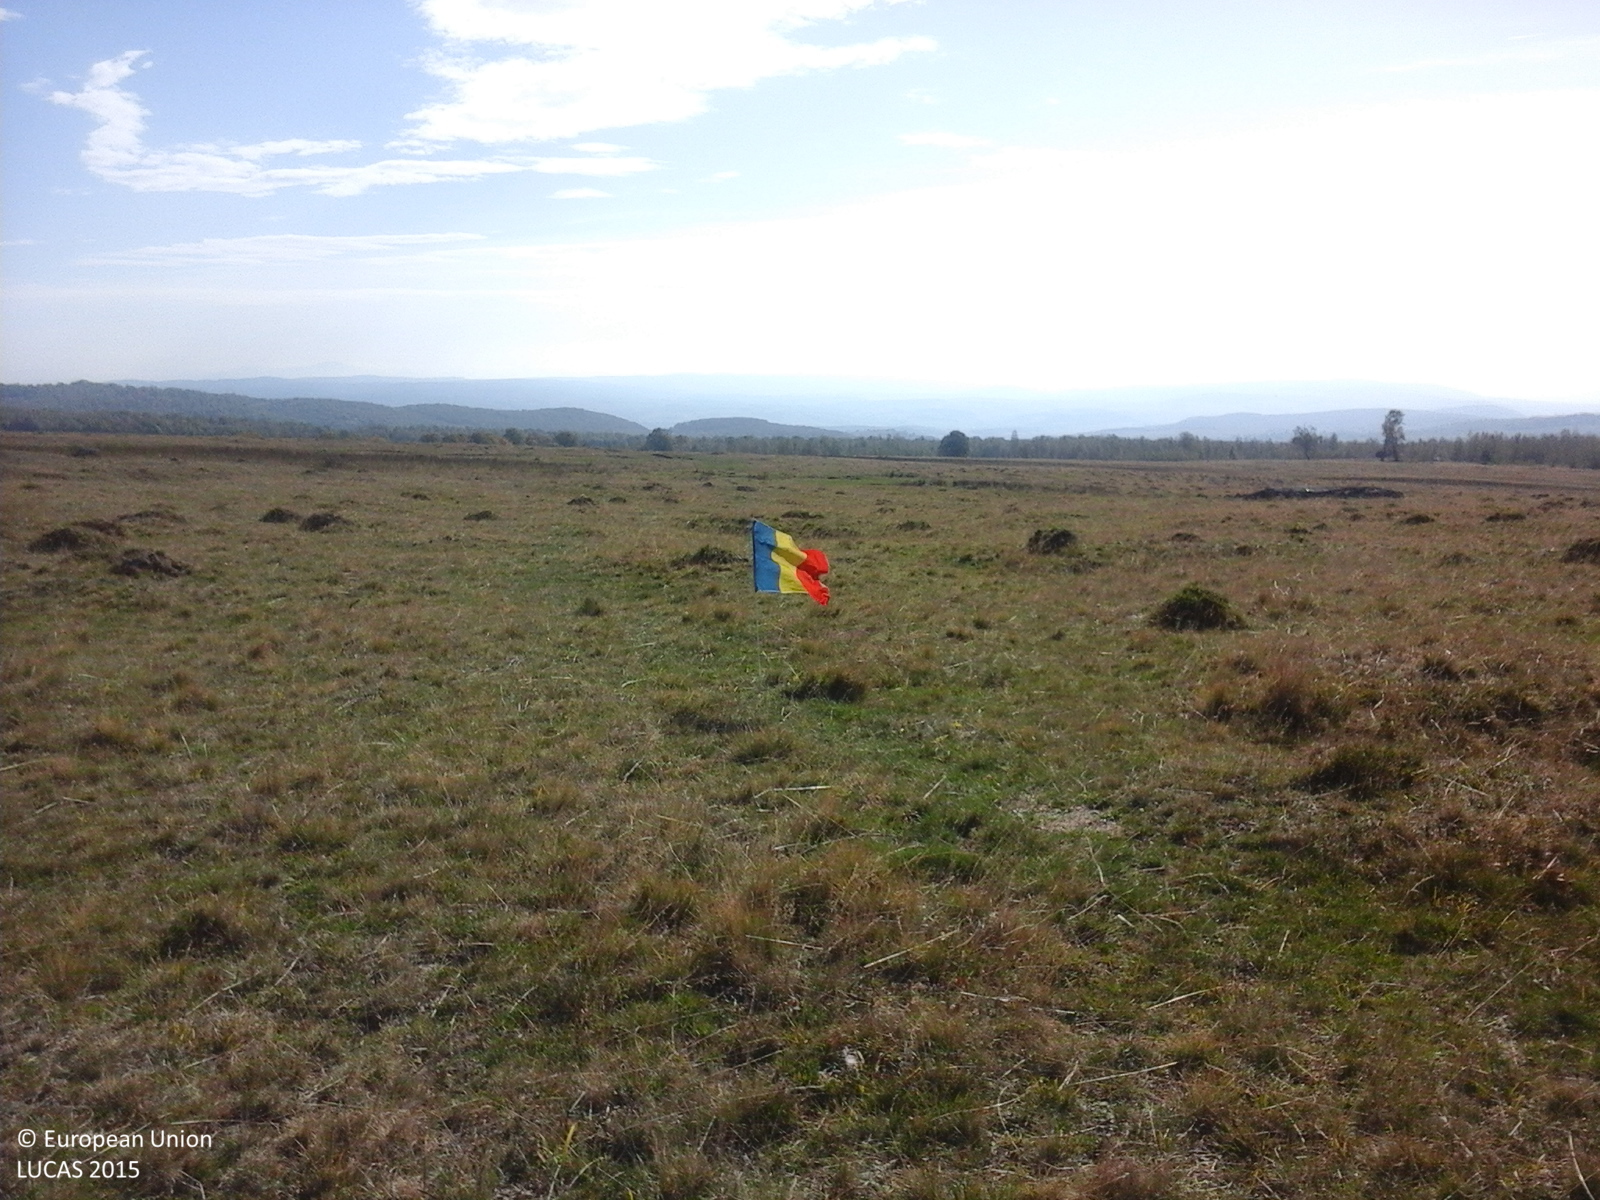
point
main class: Grassland
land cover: Grassland without tree/shrub cover
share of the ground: > 75 %
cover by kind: herbaceous plants 100 %
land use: Agriculture (excluding fallow land and kitchen gardens)
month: October
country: RO
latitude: 46.1875
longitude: 25.7241
